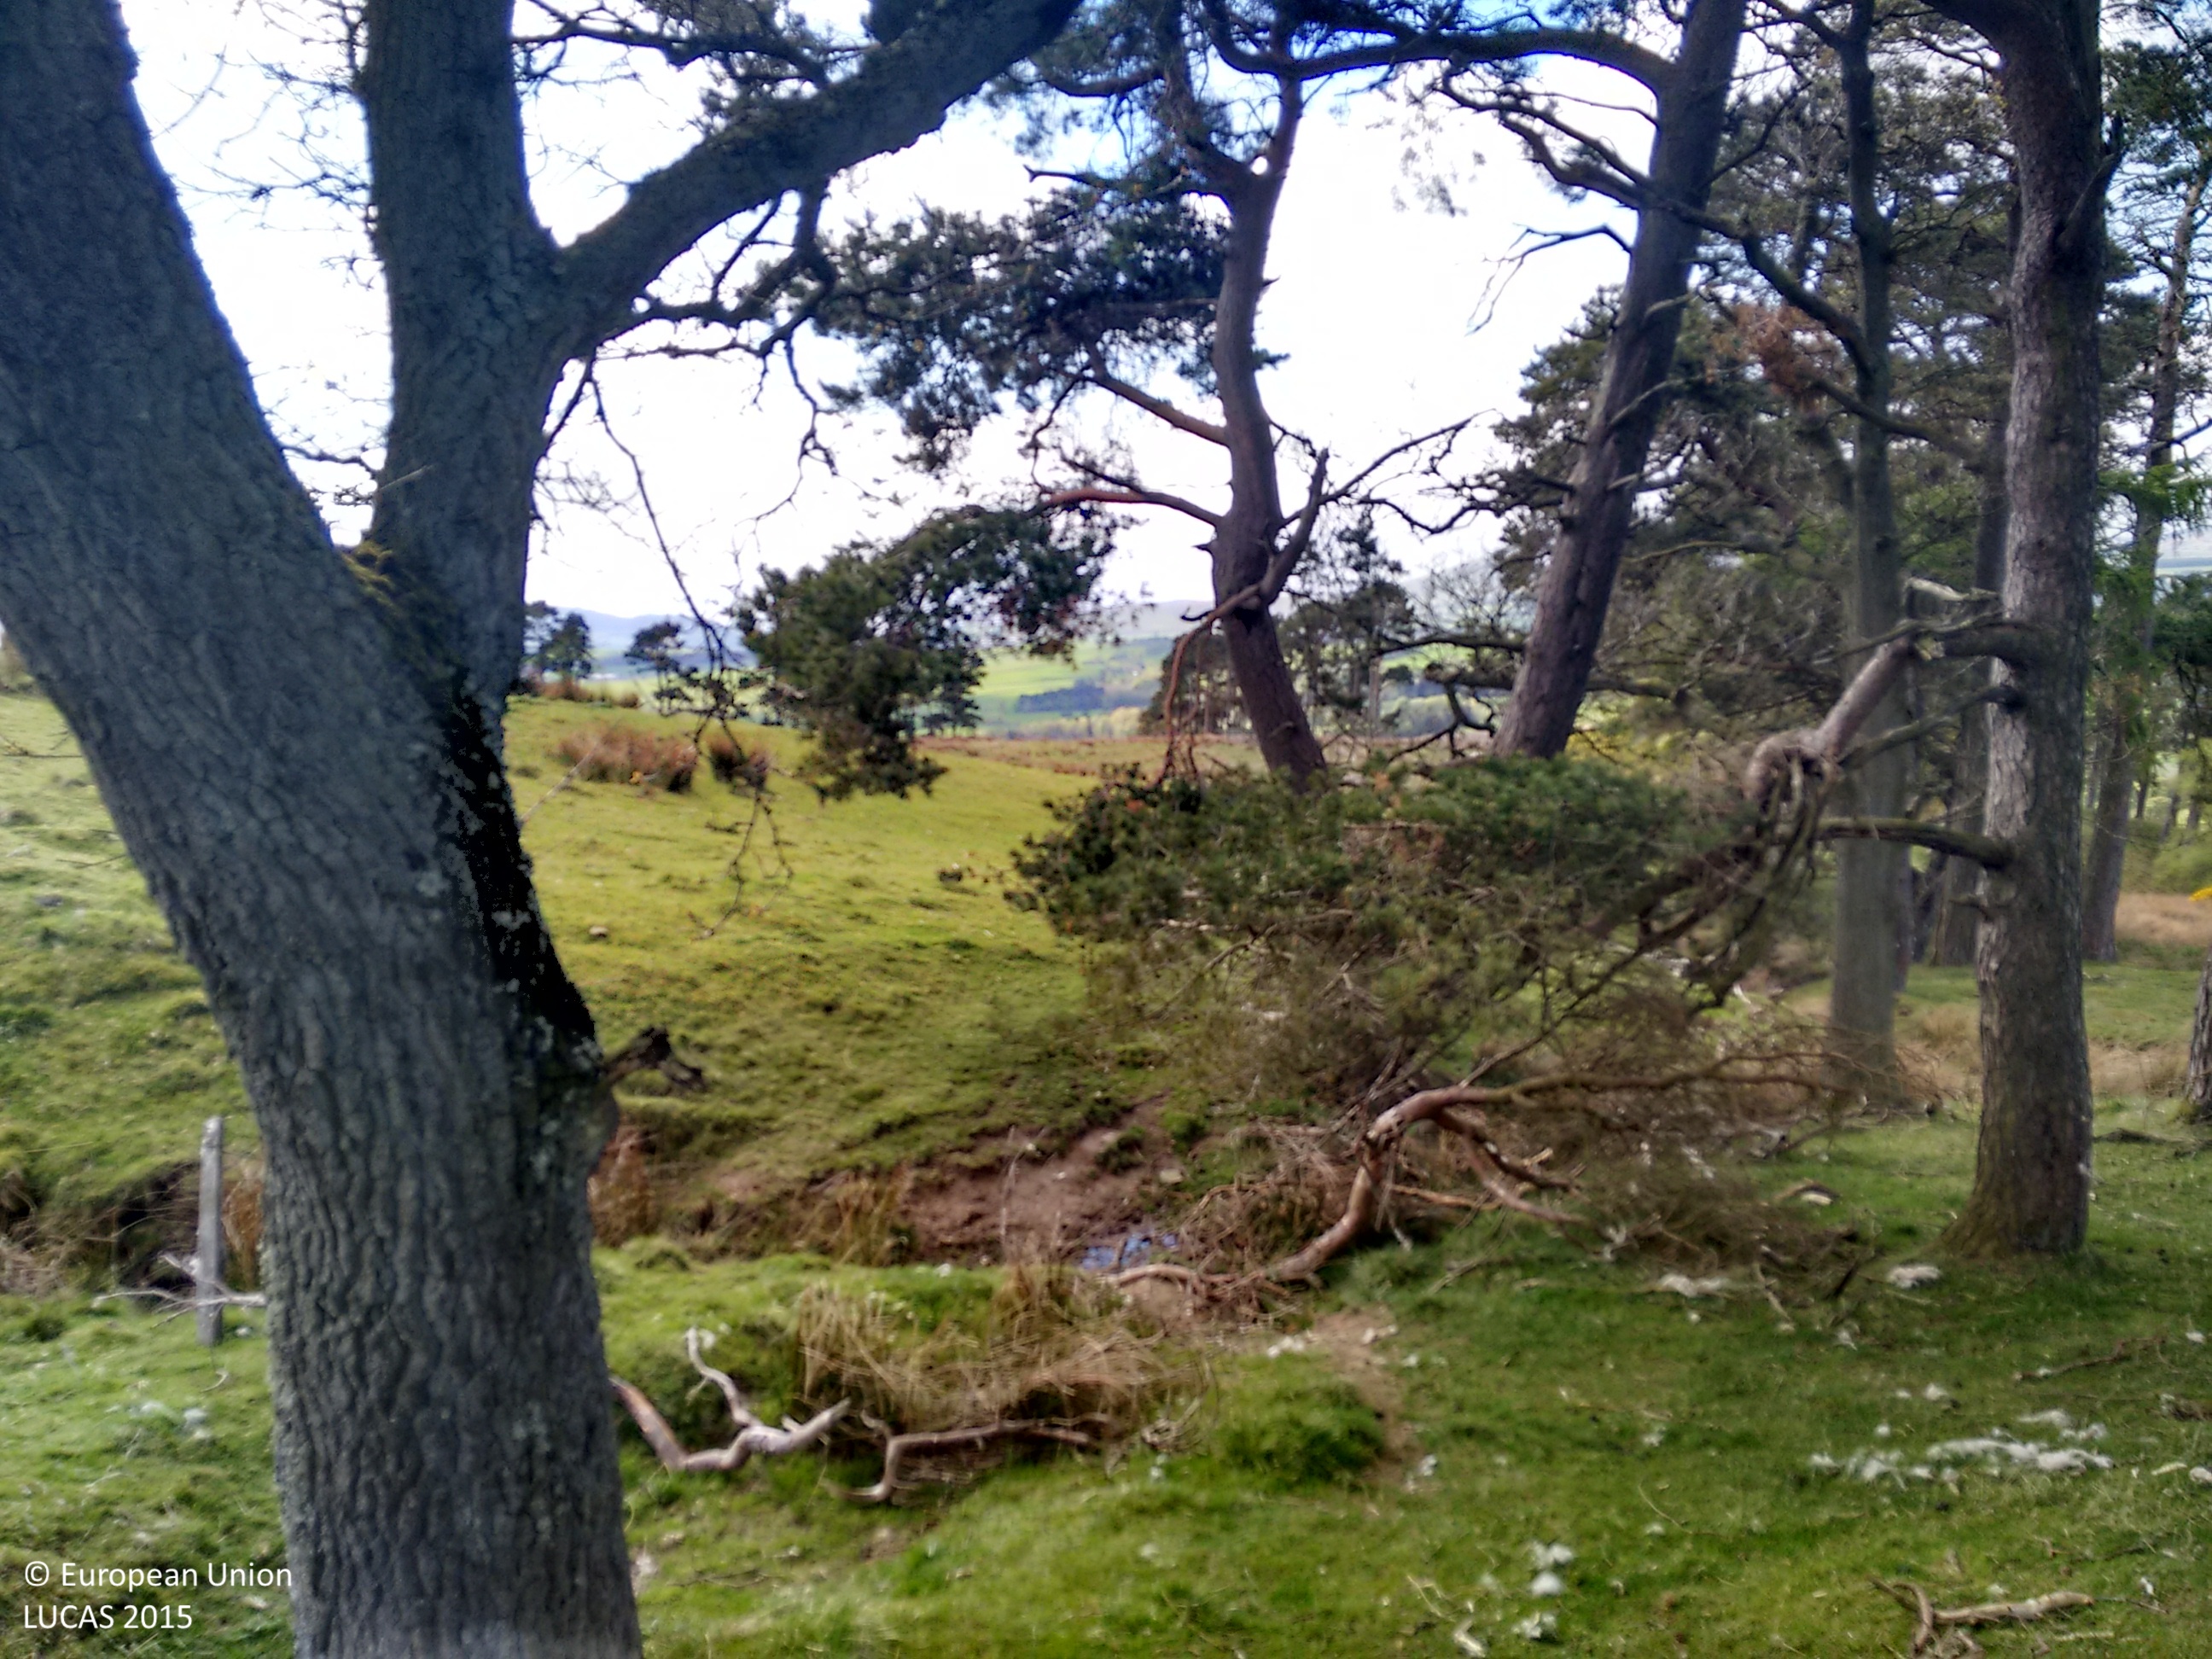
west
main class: Woodland
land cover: Pine dominated mixed woodland
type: hemiboreal forest and nemoral coniferous forest and mixed broadleaved-coniferous forest
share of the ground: > 75 %
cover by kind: coniferous forest trees 70 %, broadleaved forest trees 25 %, herbaceous plants 5 %
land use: Agriculture (excluding fallow land and kitchen gardens)
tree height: > 5 m
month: May
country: GB
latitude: 55.7279
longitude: -3.3064
